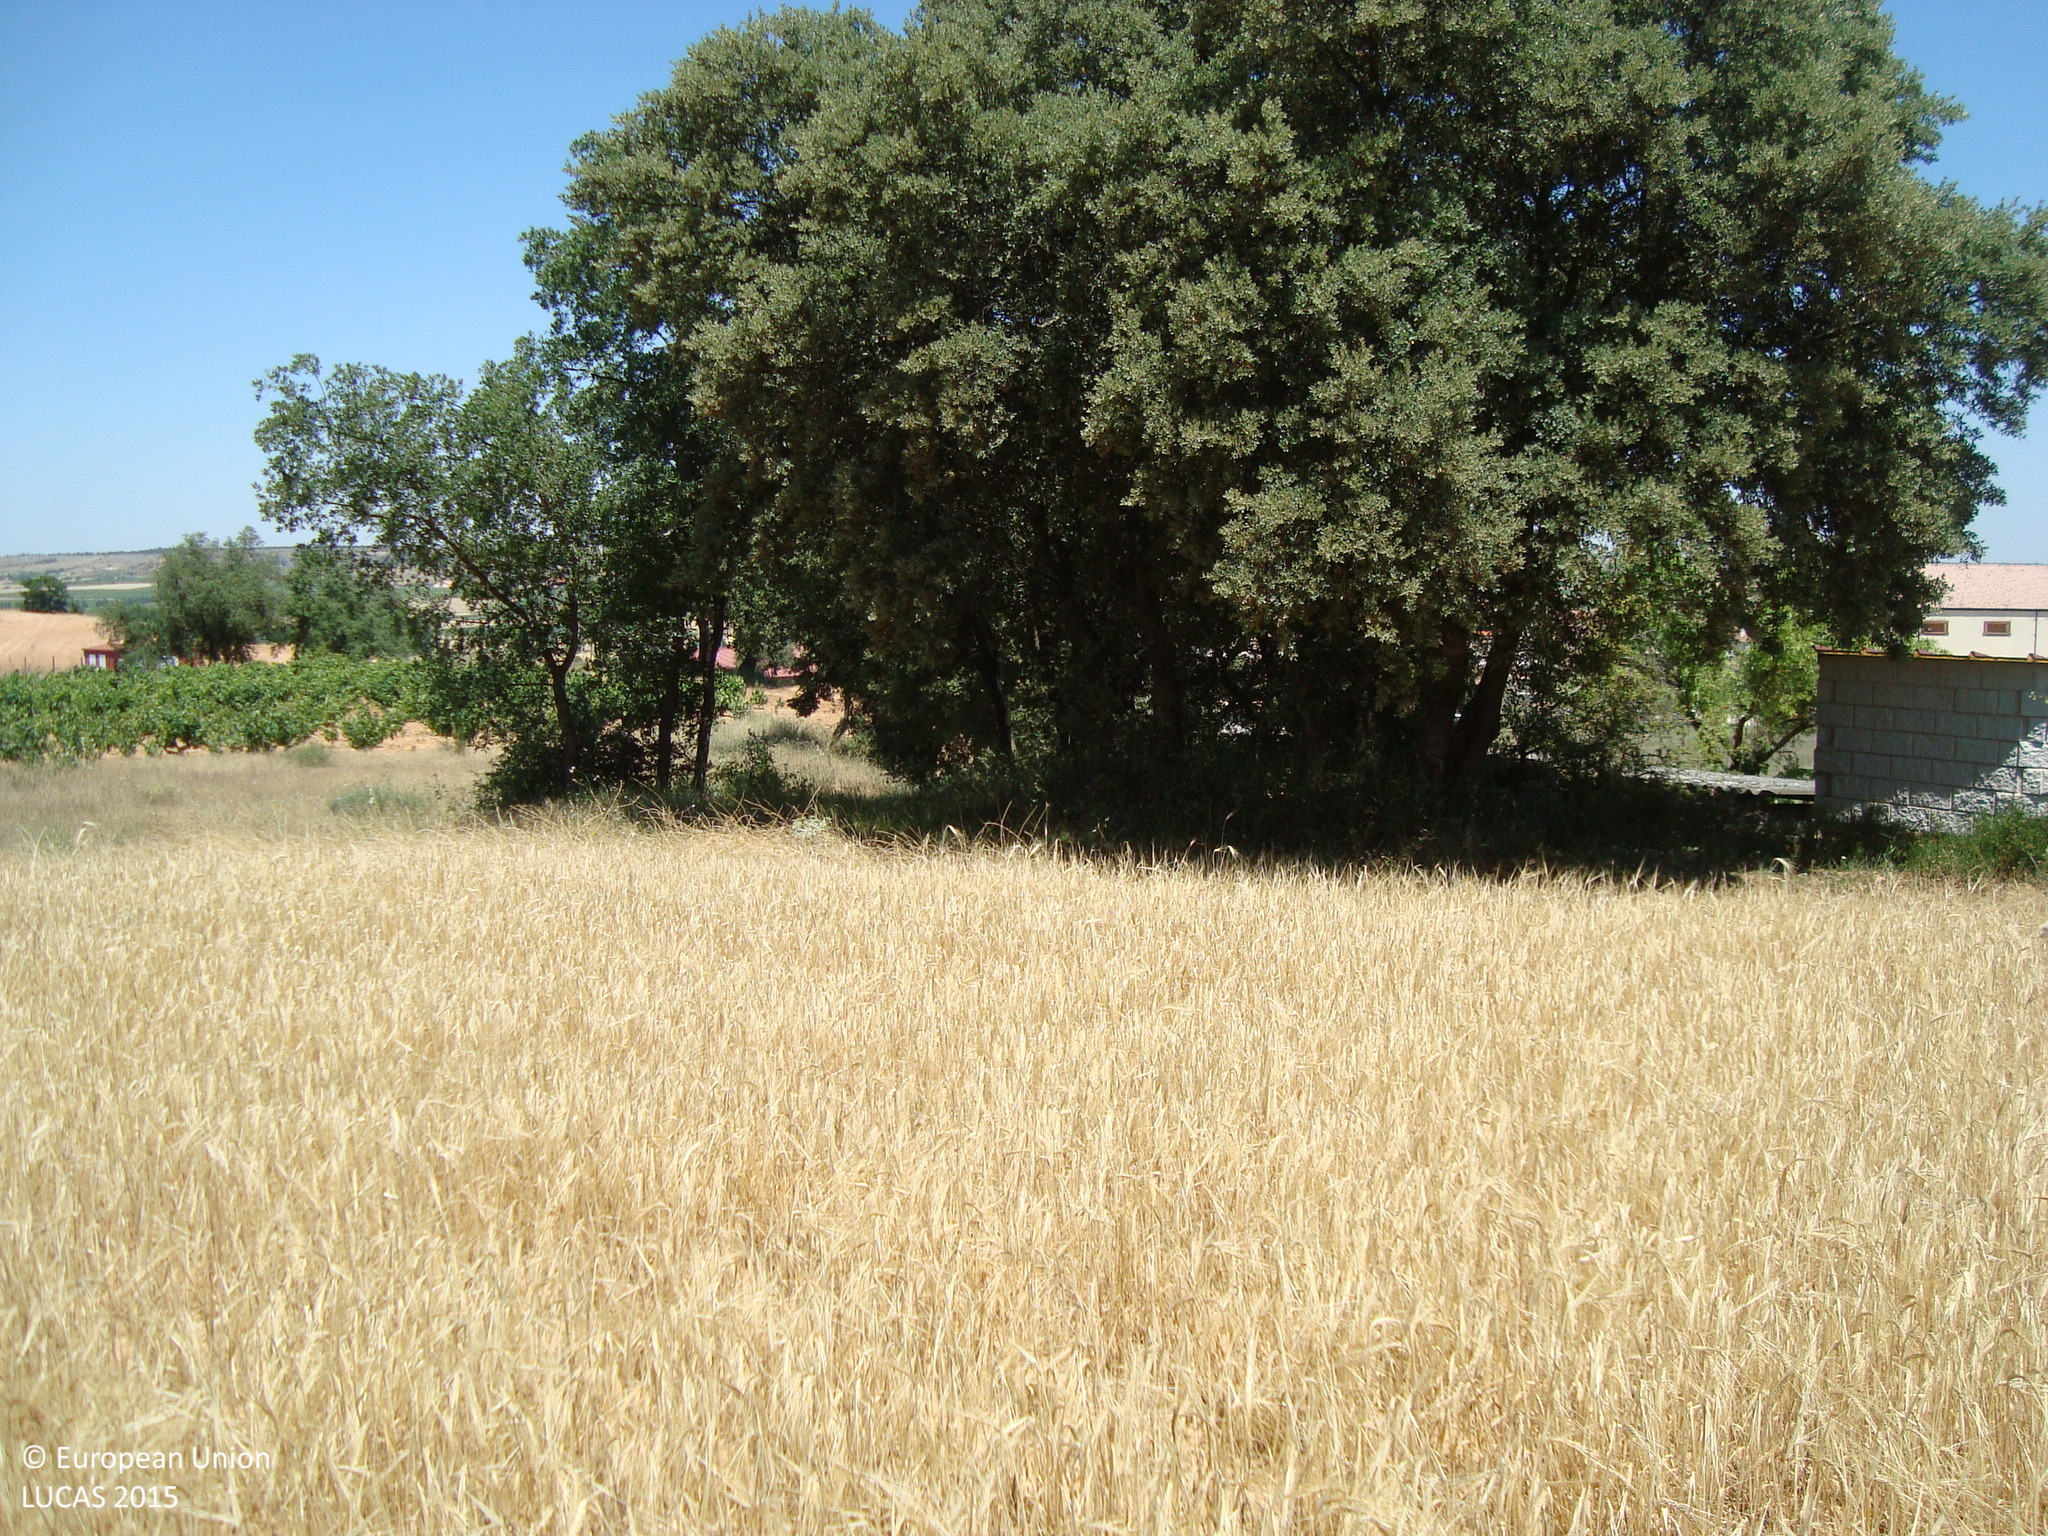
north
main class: Cropland
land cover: Barley
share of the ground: > 75 %
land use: Agriculture (excluding fallow land and kitchen gardens)
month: June
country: ES
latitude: 41.7266
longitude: -3.7711
